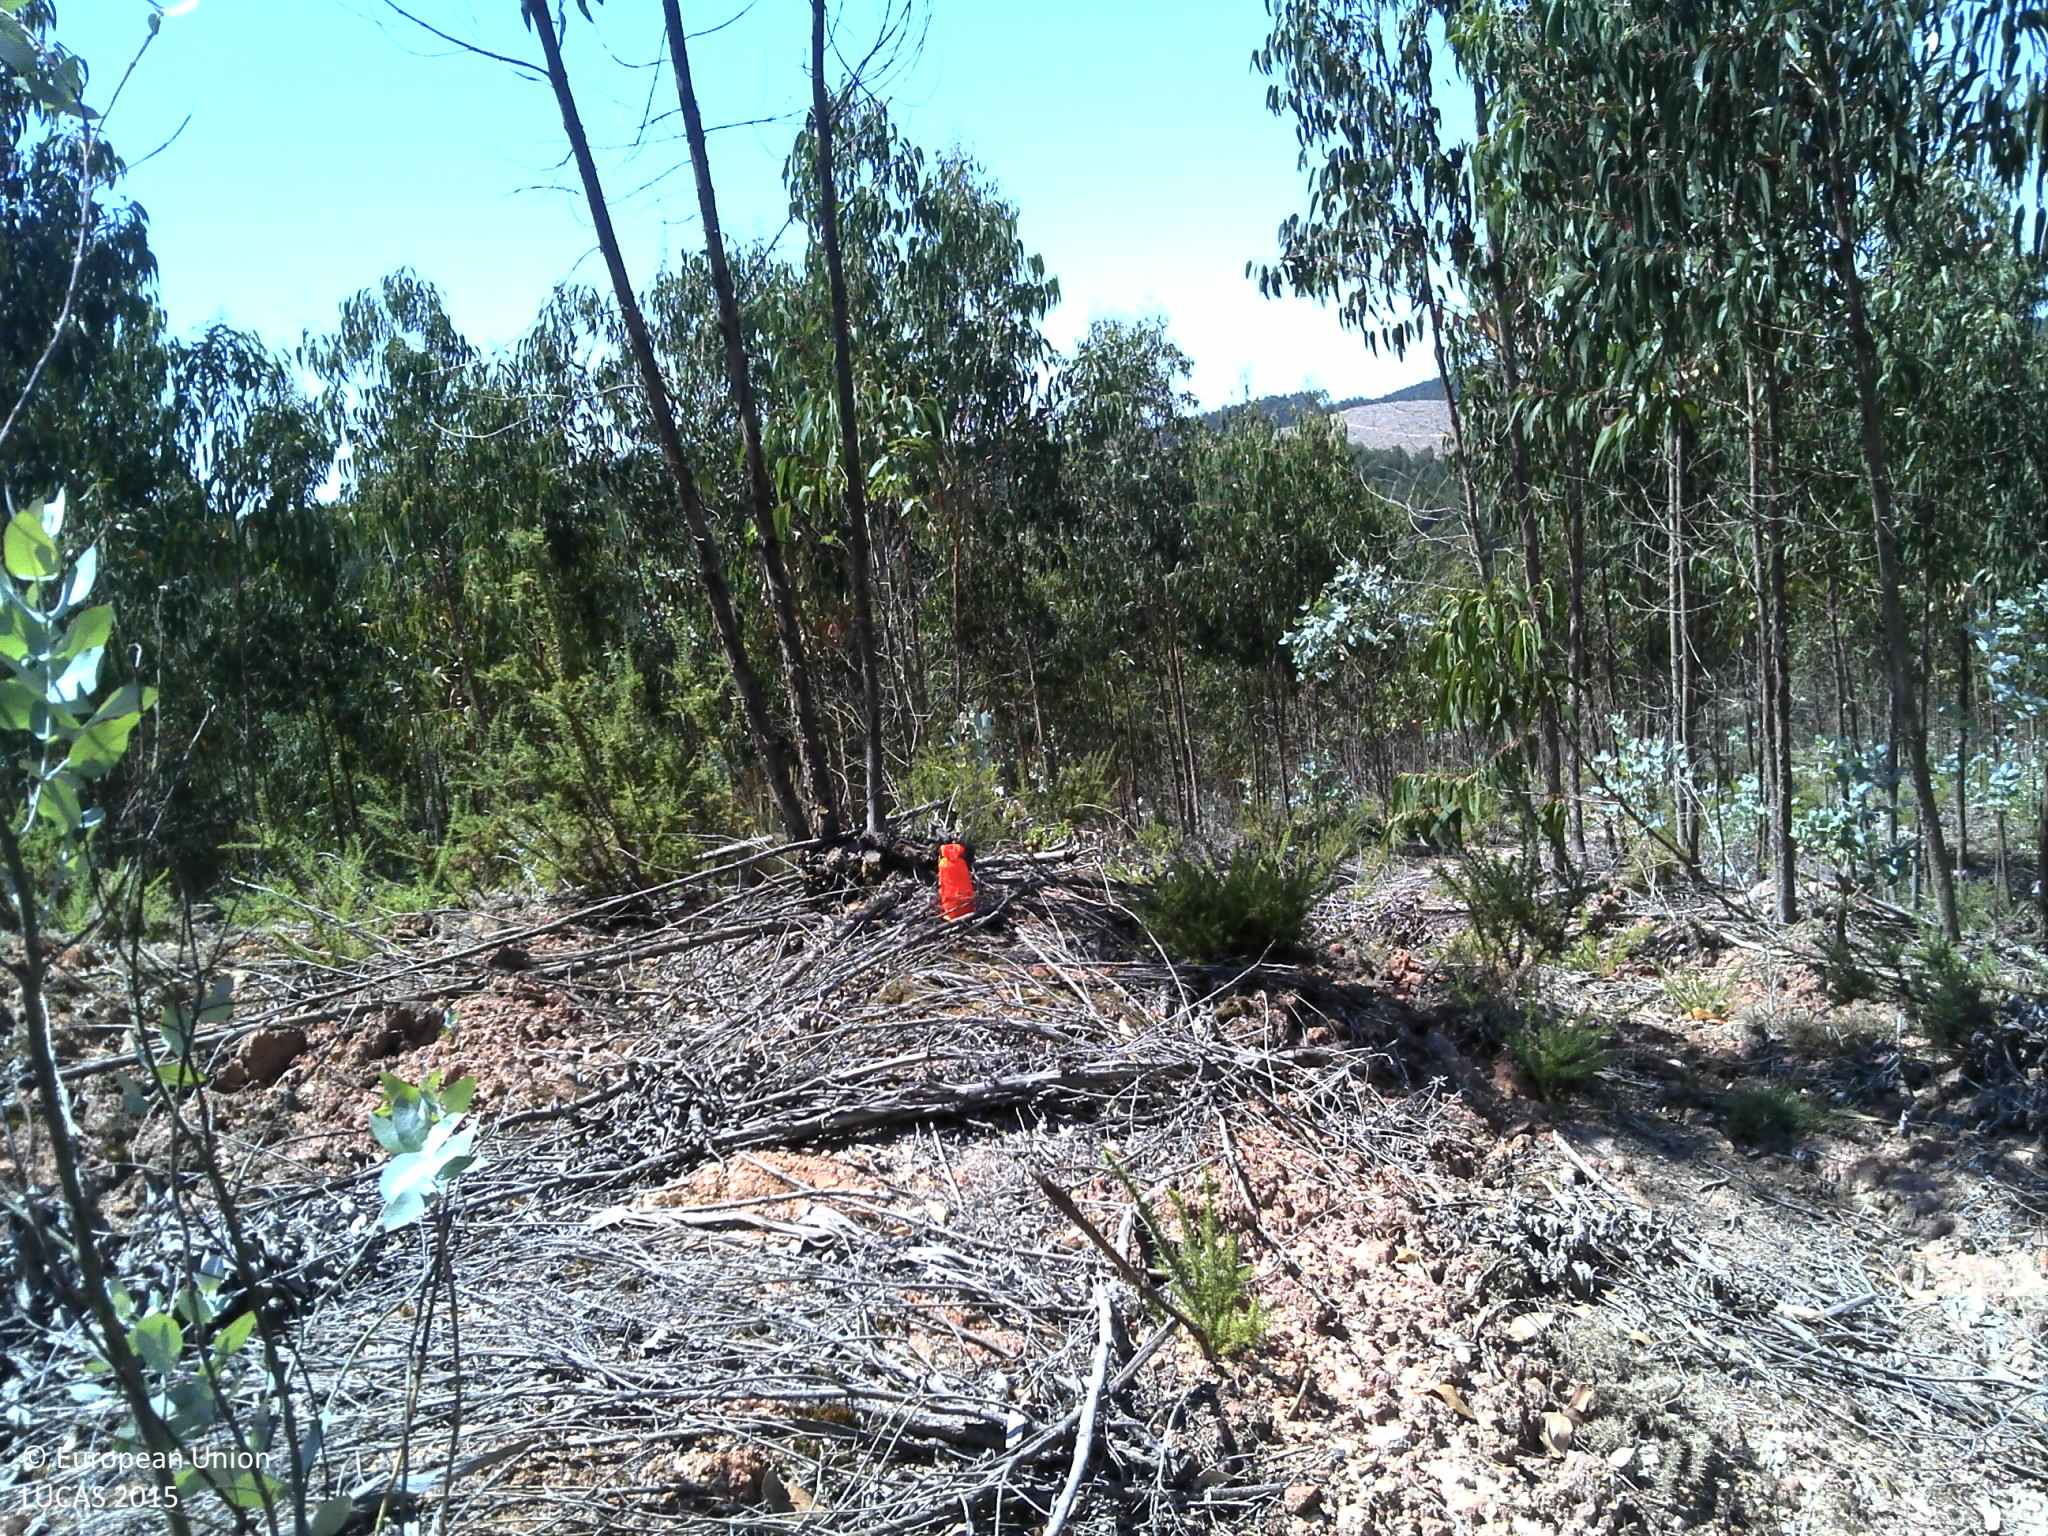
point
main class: Woodland
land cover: Broadleaved woodland
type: exotic forest
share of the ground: 25 - 50 %
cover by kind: broadleaved forest trees 45 %, unconsolidated bare surface 40 %, shrubs 15 %
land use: Forestry
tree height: > 5 m
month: June
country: PT
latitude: 39.1317
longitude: -9.2793
